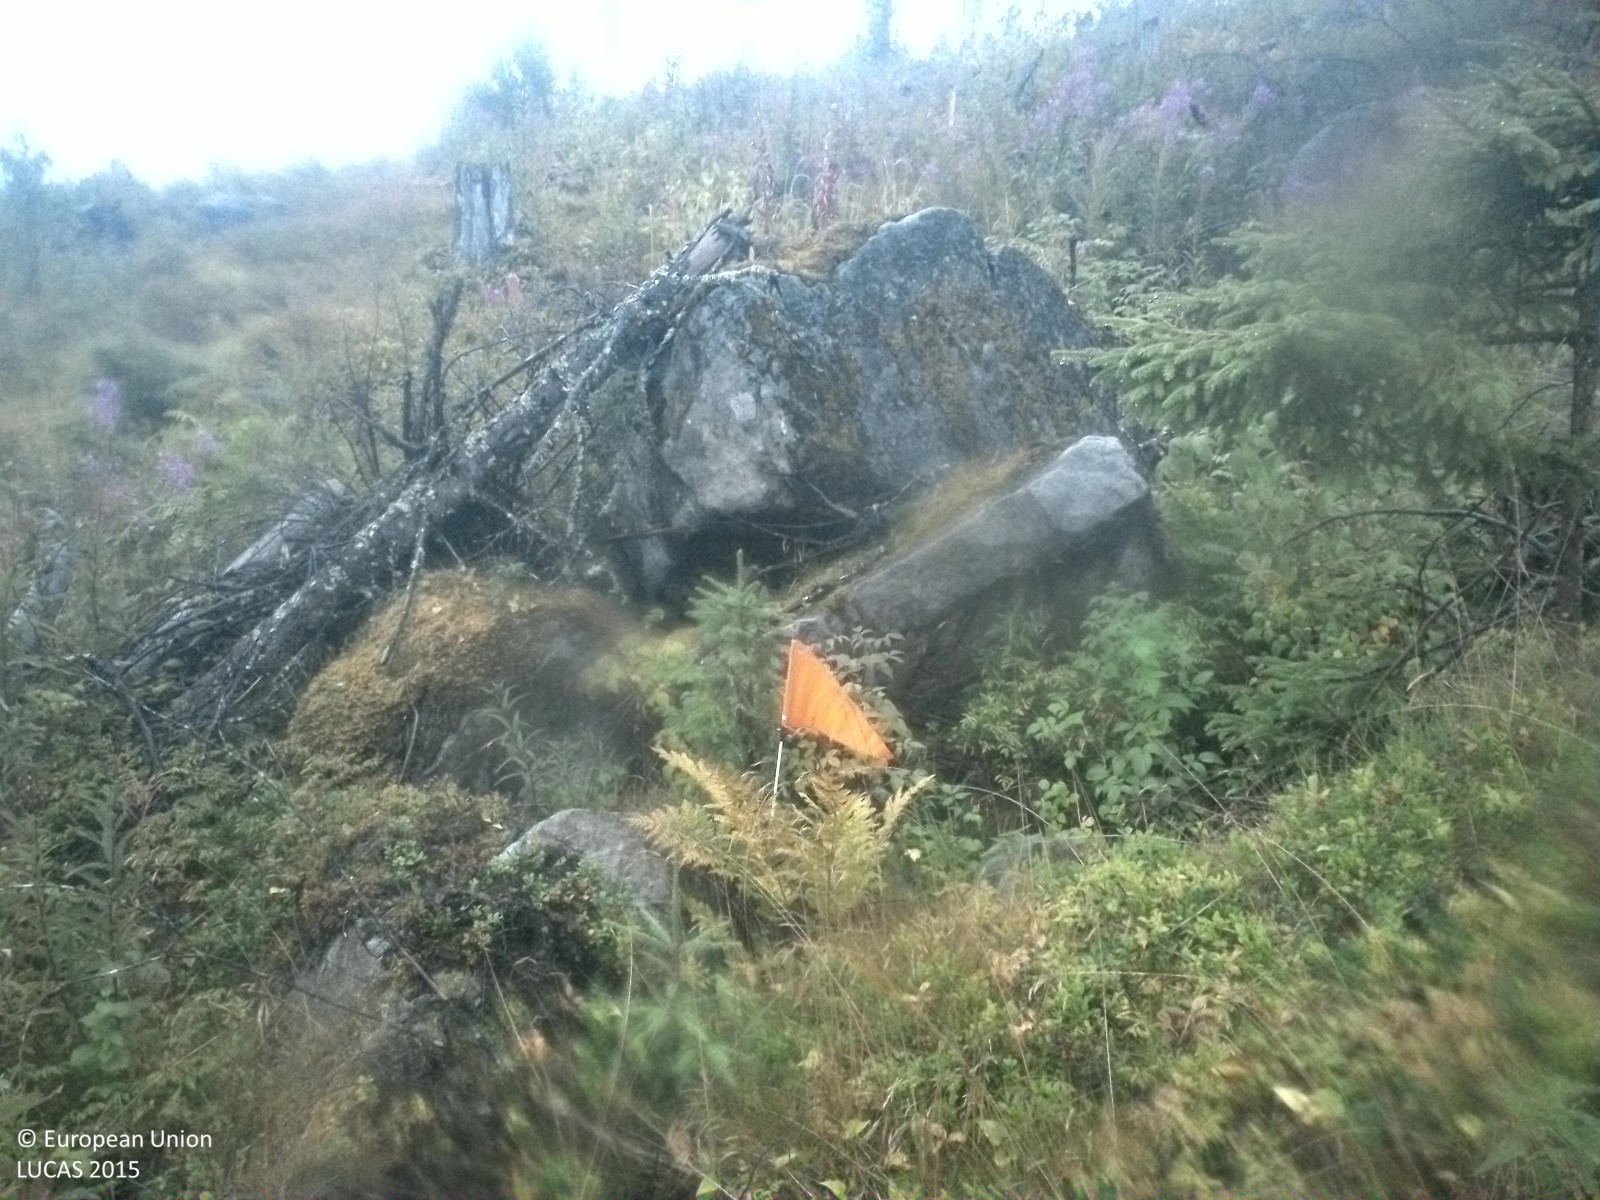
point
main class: Woodland
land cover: Spruce dominated mixed woodland
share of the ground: 10 - 25 %
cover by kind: herbaceous plants 35 %, shrubs 30 %, coniferous forest trees 15 %, consolidated bare surface 10 %, broadleaved forest trees 5 %, unconsolidated bare surface 5 %
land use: Forestry
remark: Clear cut
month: August
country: SE
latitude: 62.3719
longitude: 16.3007
